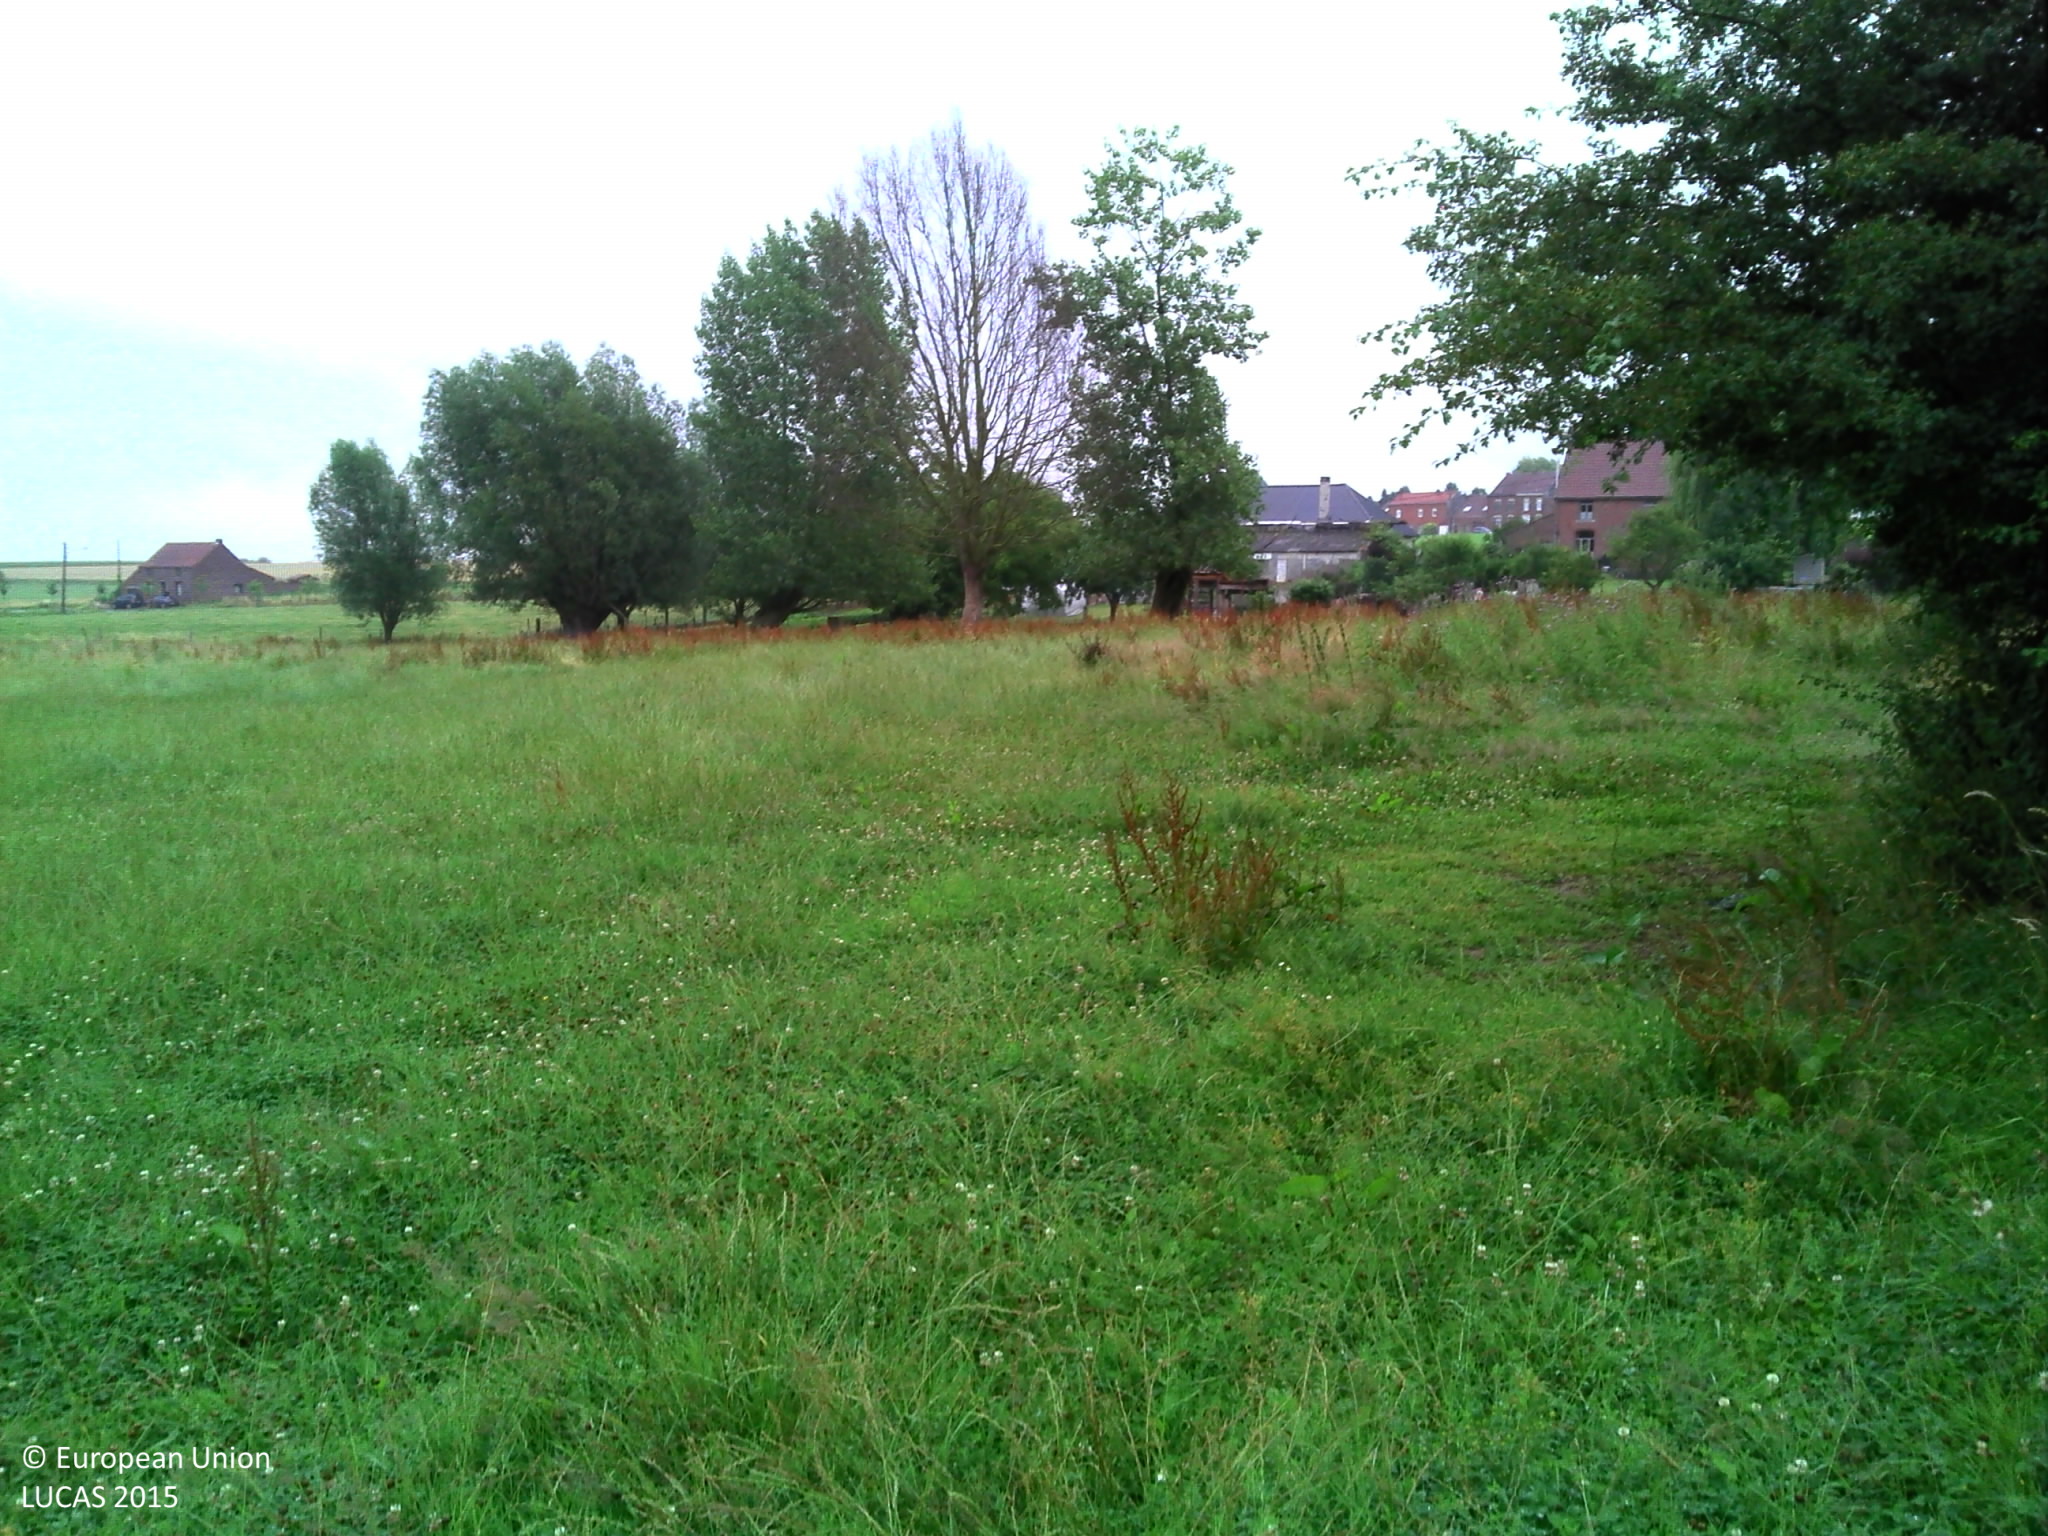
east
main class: Grassland
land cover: Grassland without tree/shrub cover
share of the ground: > 75 %
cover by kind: herbaceous plants 100 %
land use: Agriculture (excluding fallow land and kitchen gardens)
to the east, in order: Grassland without tree/shrub cover; Fences; Grassland without tree/shrub cover; Single bushes/trees; Grassland without tree/shrub cover; Artificial constructions in urban areas; Clovers
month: July
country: BE
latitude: 50.5848
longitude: 3.9916
